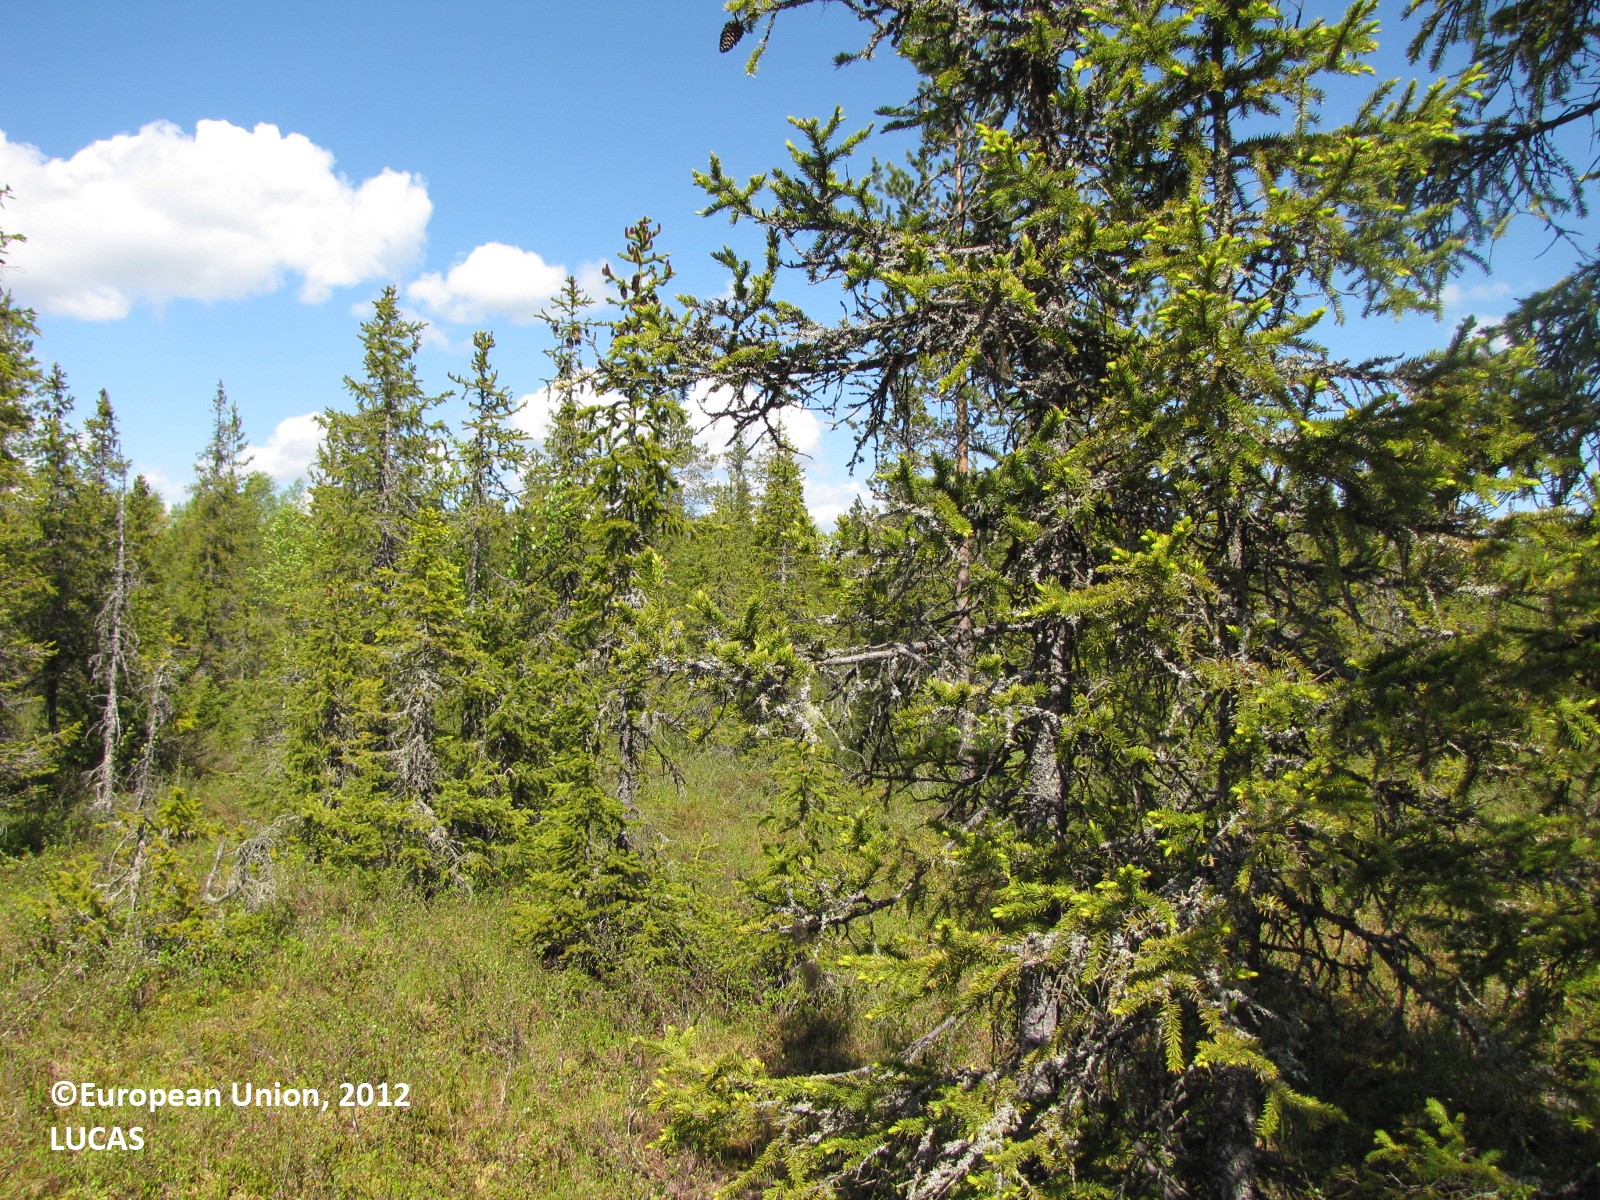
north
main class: Woodland
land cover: Spruce dominated coniferous woodland
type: boreal forest
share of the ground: 25 - 50 %
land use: Forestry
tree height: > 5 m
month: June
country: FI
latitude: 65.9757
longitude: 24.7380
